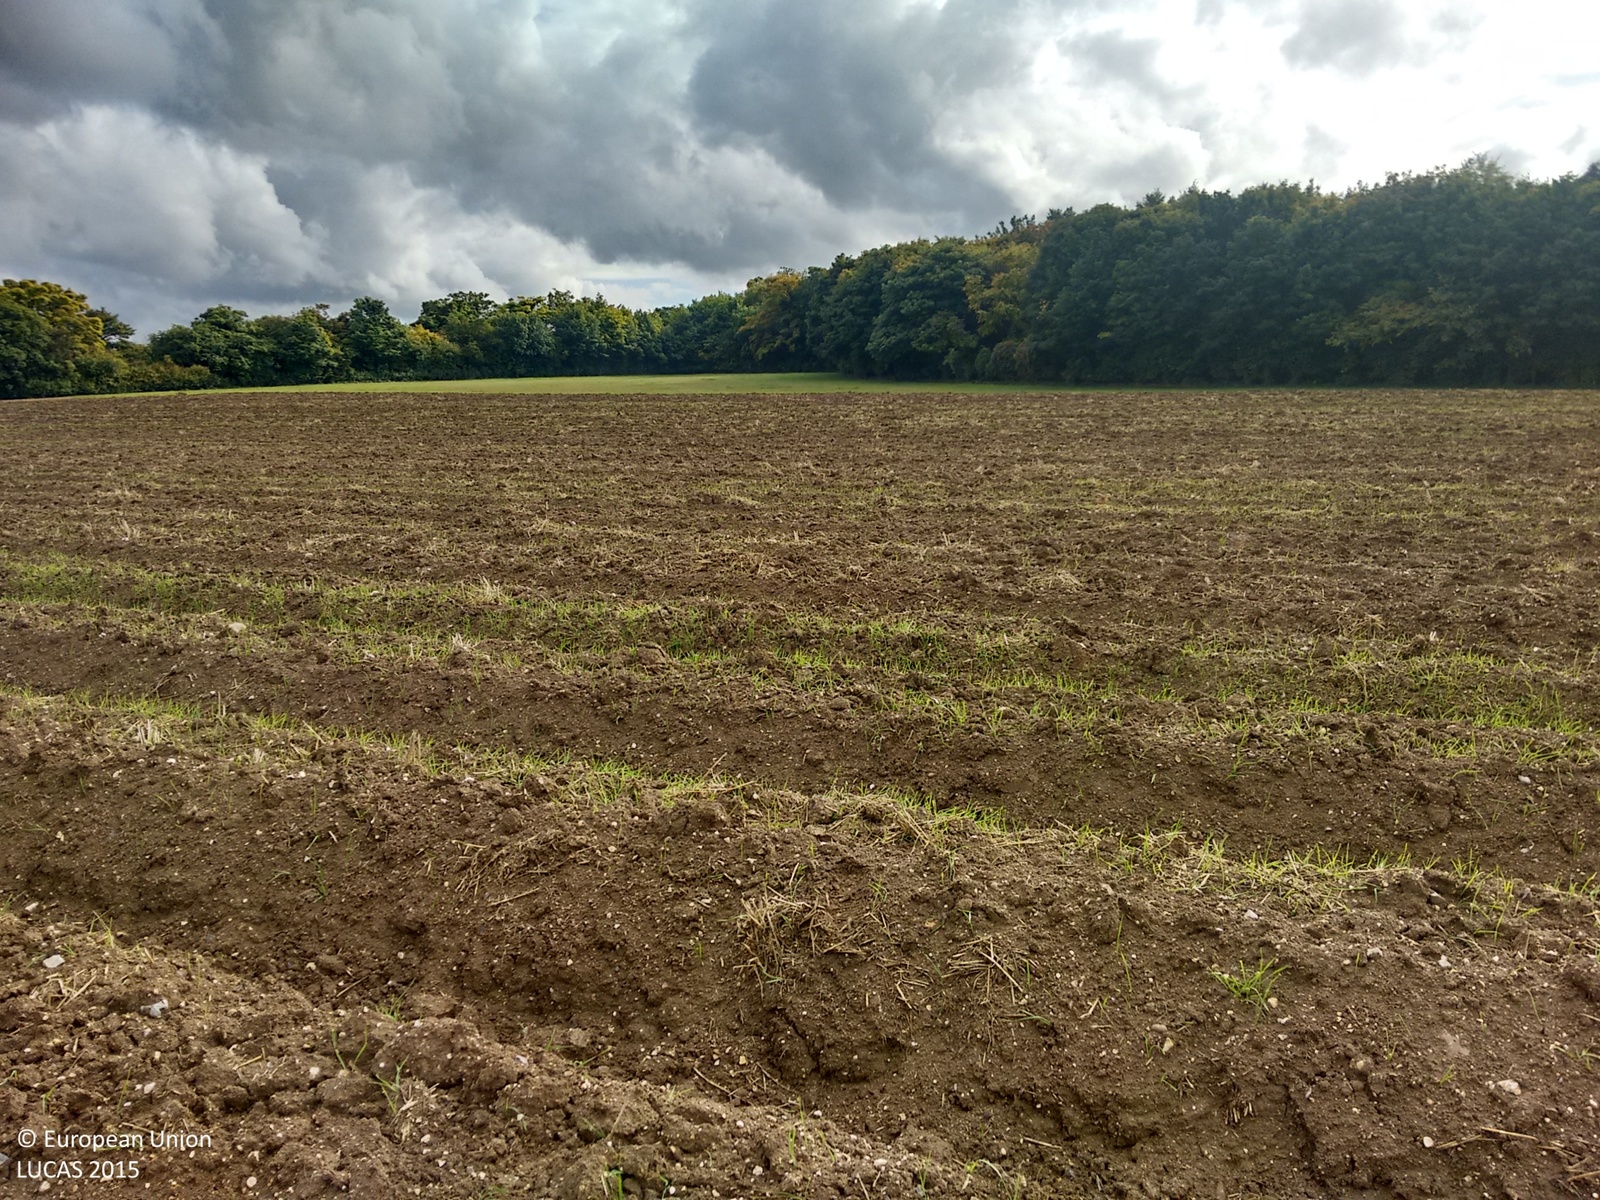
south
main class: Cropland
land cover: Potatoes
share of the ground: < 10 %
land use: Agriculture (excluding fallow land and kitchen gardens)
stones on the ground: < 10 %
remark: Harvested field
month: October
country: GB
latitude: 52.0981
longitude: 0.2034
